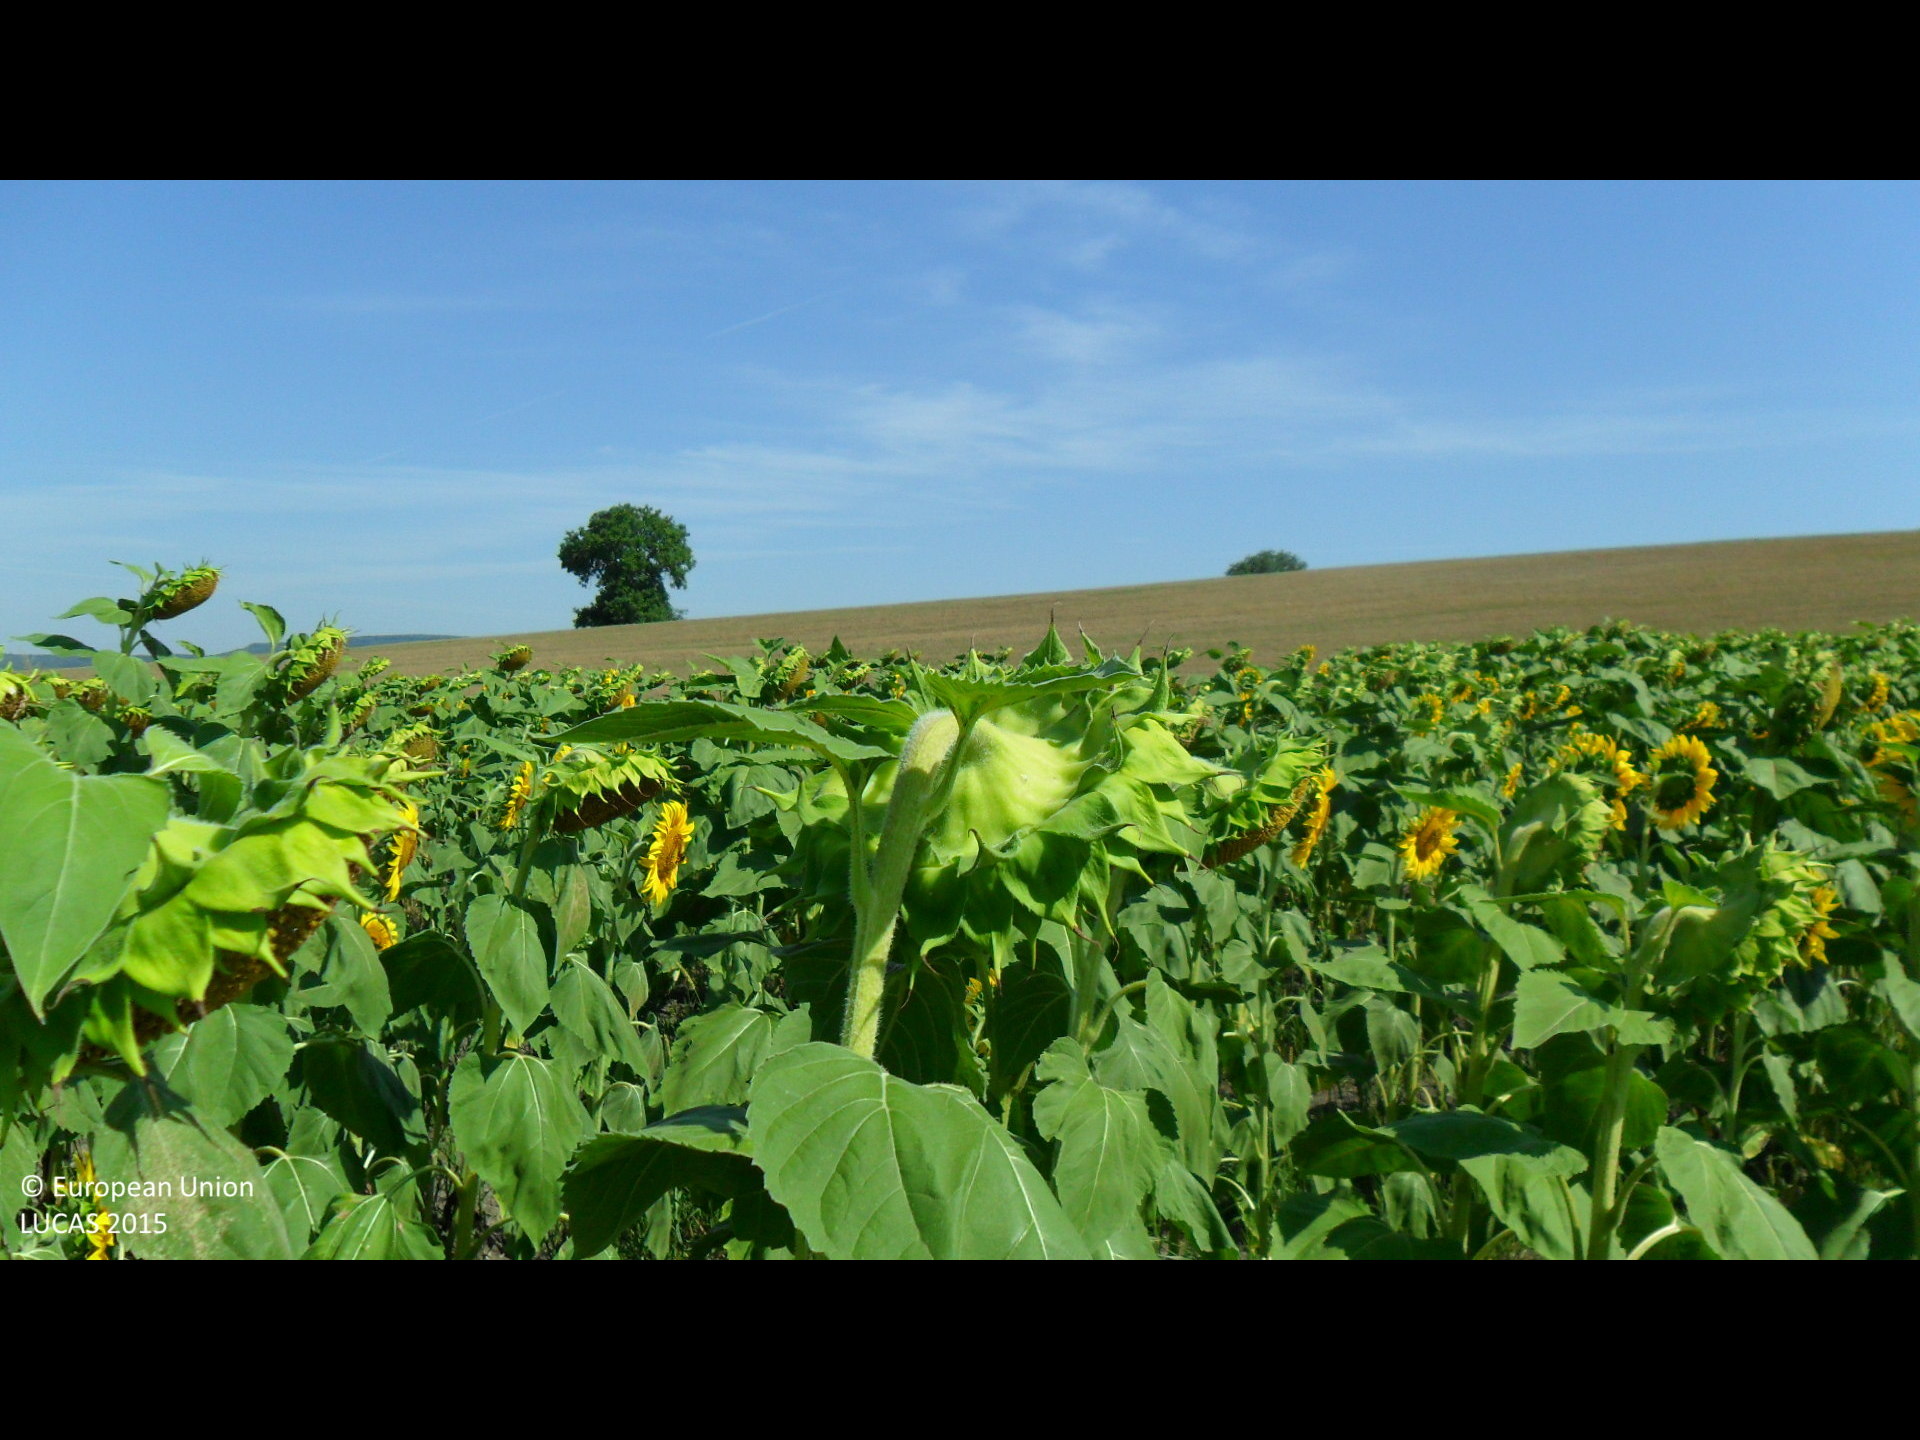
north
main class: Cropland
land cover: Sunflower
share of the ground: > 75 %
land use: Agriculture (excluding fallow land and kitchen gardens)
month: August
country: BG
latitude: 43.3537
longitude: 26.4744
